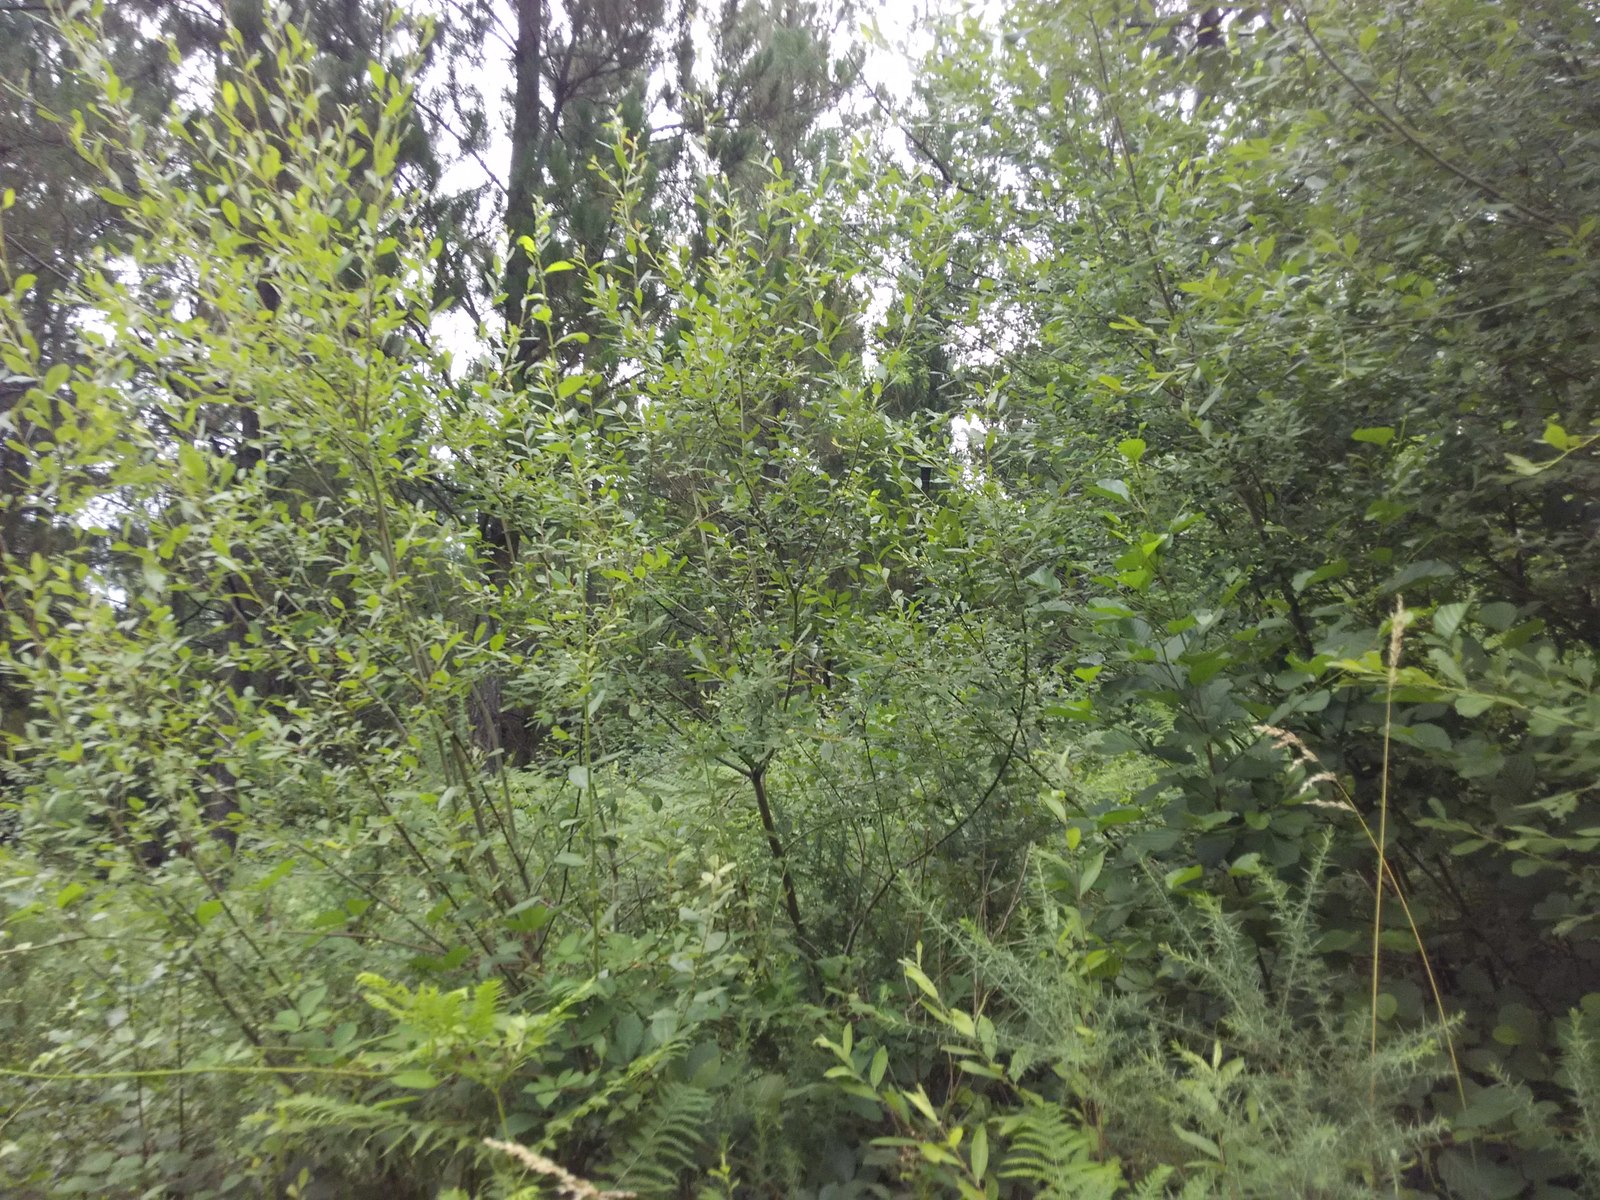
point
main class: Woodland
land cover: Pine dominated coniferous woodland
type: exotic forest
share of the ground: > 75 %
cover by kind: coniferous forest trees 90 %, shrubs 10 %
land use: Forestry
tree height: > 5 m
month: July
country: ES
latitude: 43.0400
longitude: -2.2365
